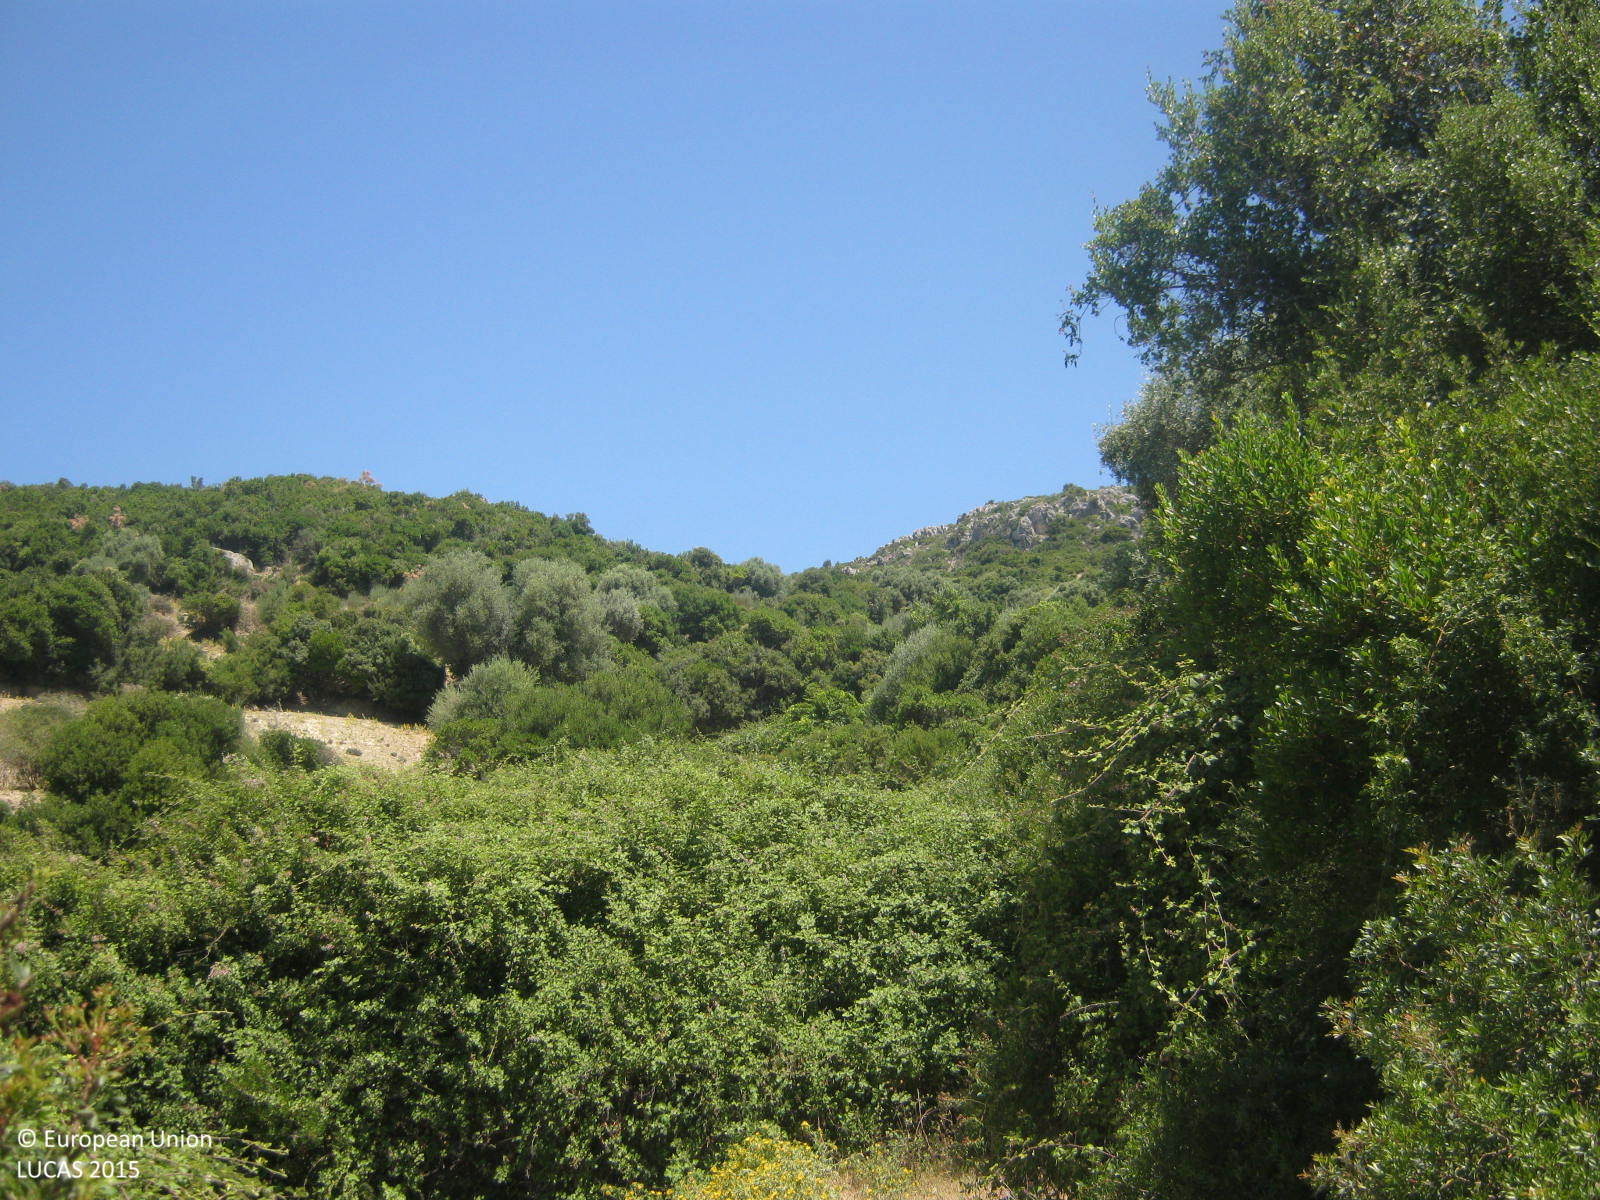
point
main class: Grassland
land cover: Grassland with sparse tree/shrub cover
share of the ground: > 75 %
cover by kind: herbaceous plants 75 %, shrubs 10 %, unconsolidated bare surface 10 %, broadleaved forest trees 5 %
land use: Fallow land
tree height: < 5 m
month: June
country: GR
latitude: 38.8289
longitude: 20.8086
